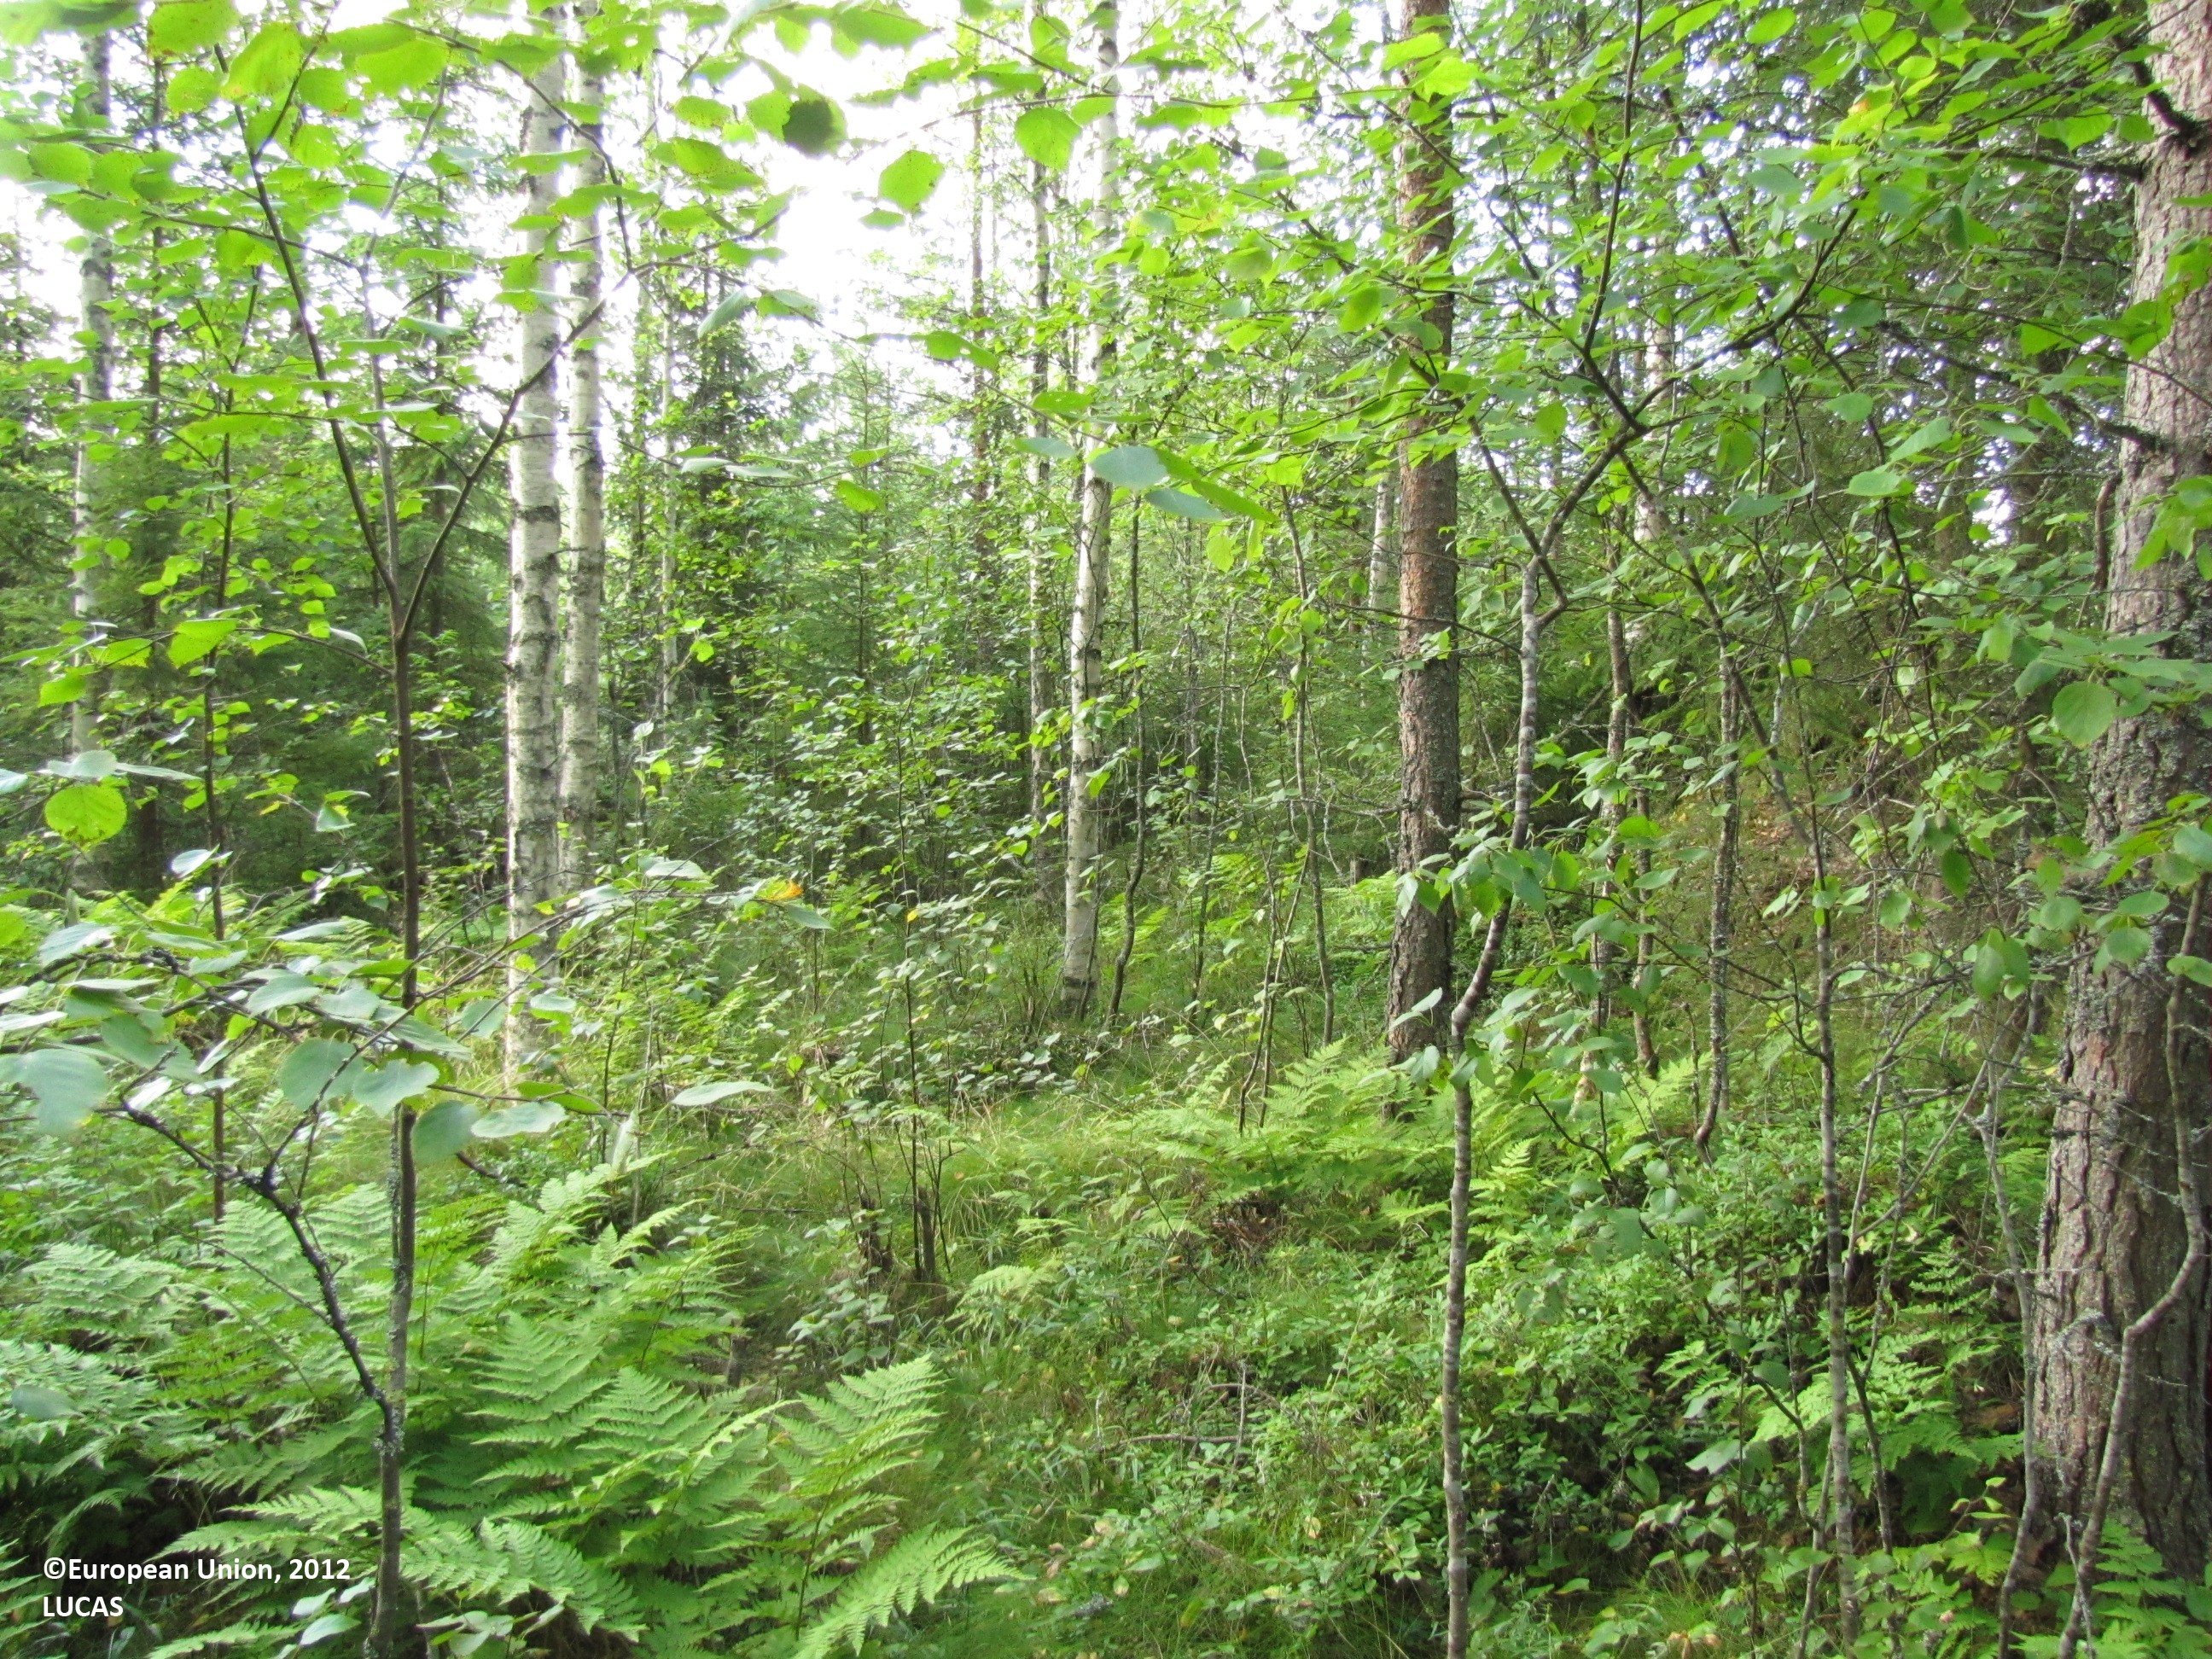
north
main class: Woodland
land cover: Spruce dominated mixed woodland
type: boreal forest
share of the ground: 50 - 75 %
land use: Forestry
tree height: > 5 m
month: August
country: FI
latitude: 61.7104
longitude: 23.0647
